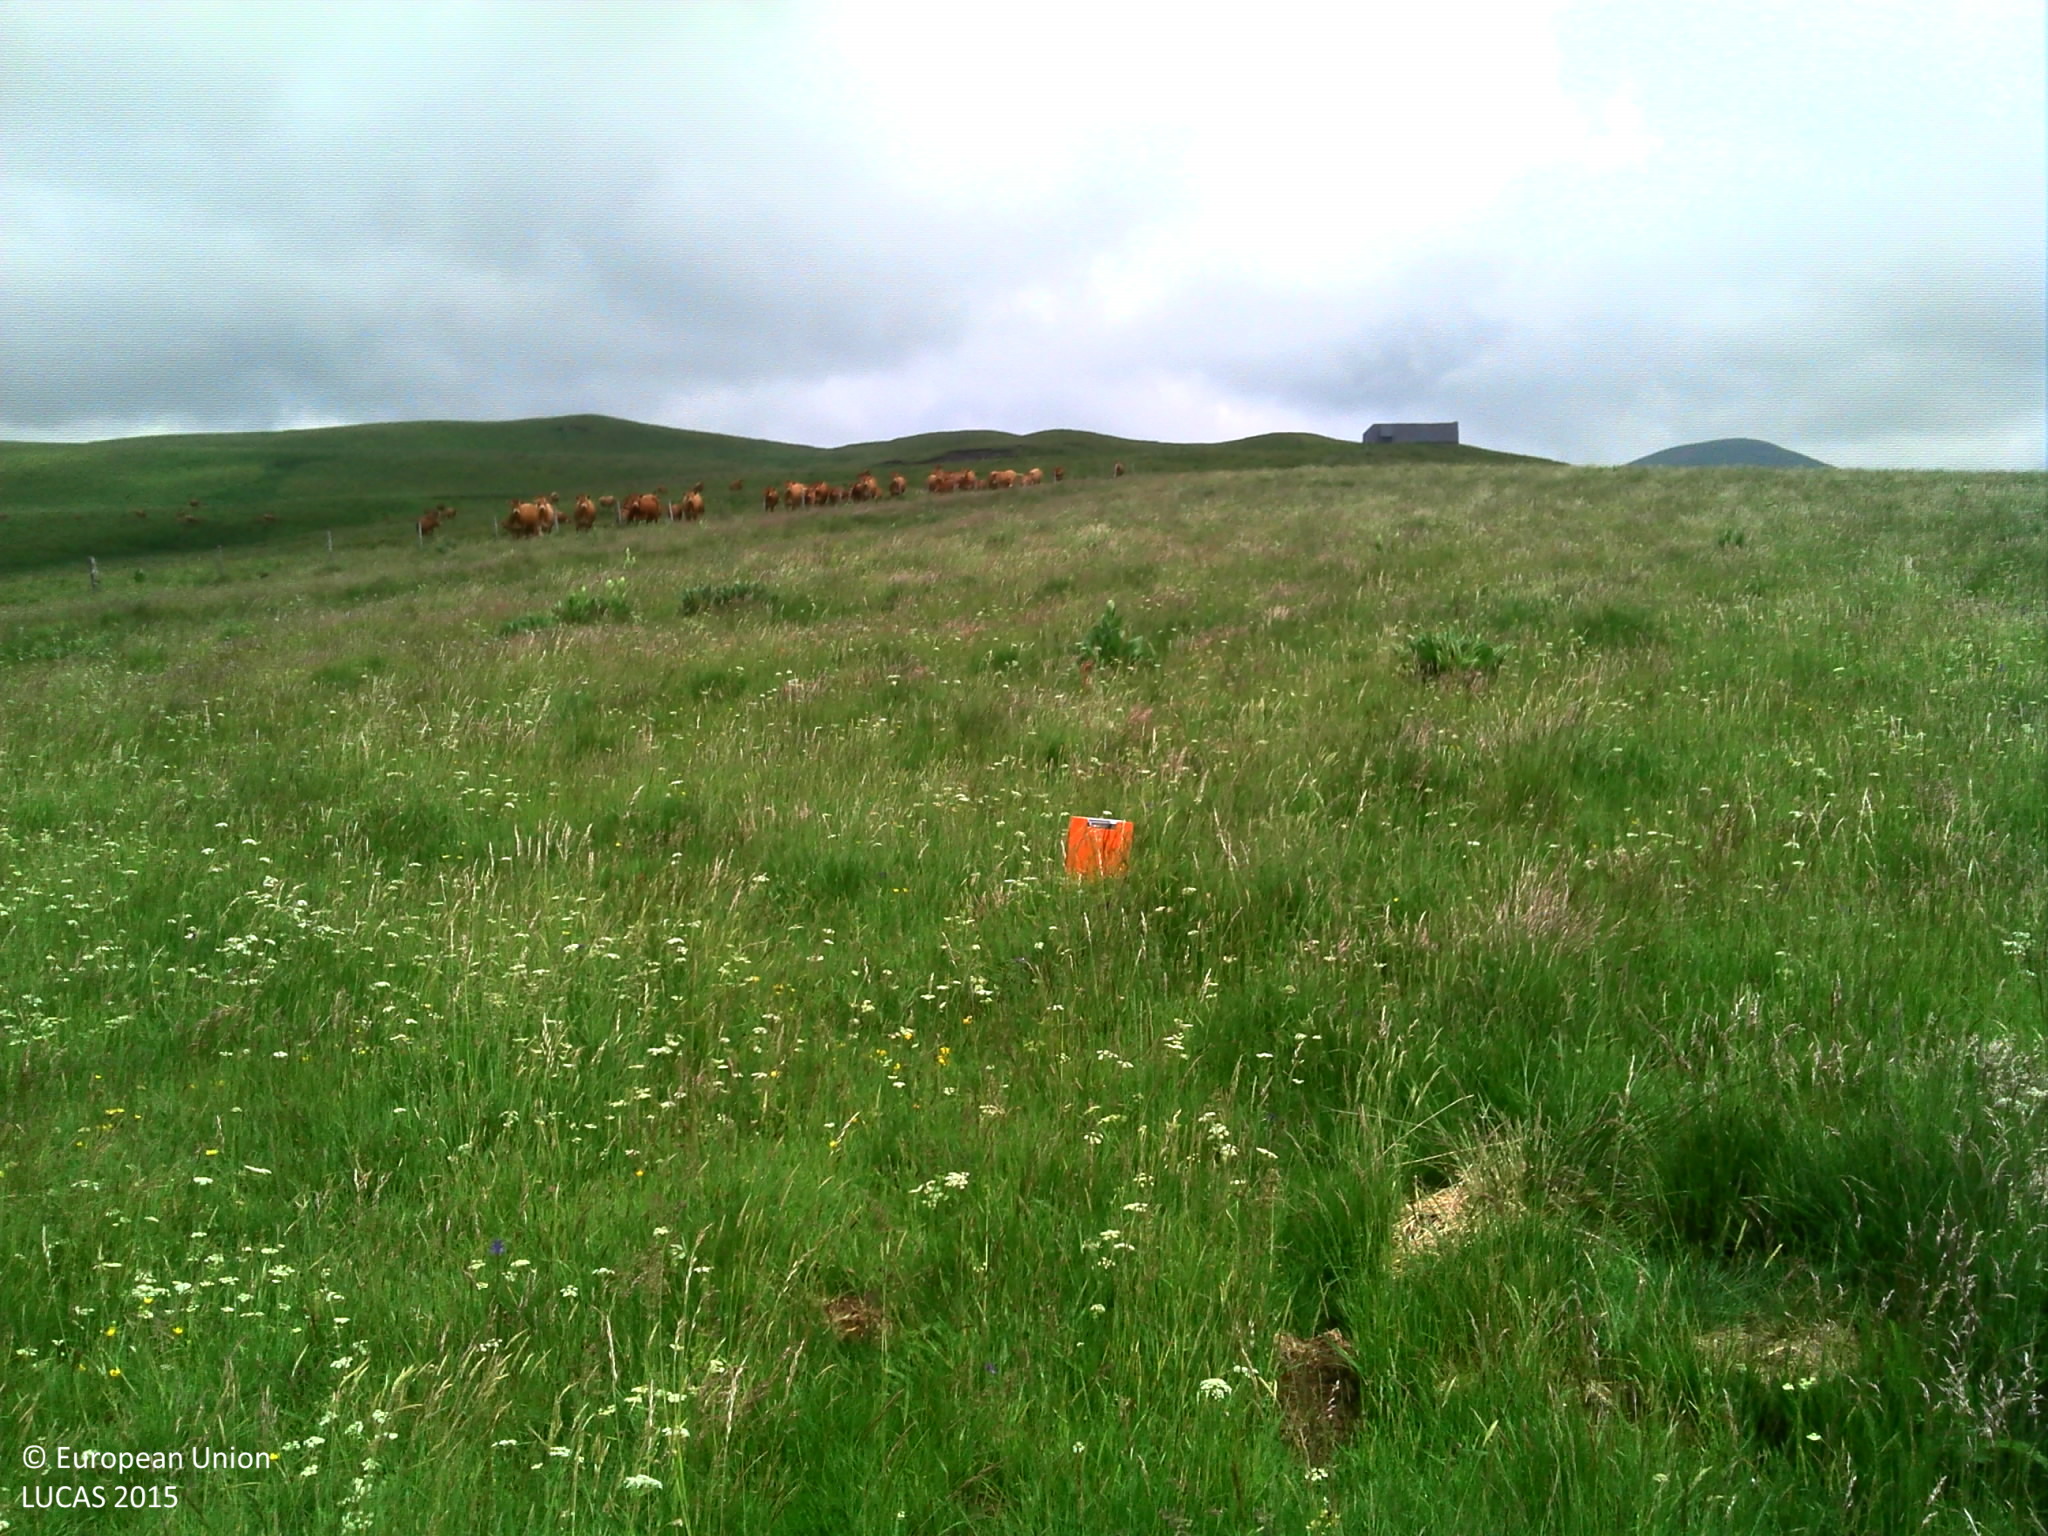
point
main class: Grassland
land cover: Grassland without tree/shrub cover
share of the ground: > 75 %
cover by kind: herbaceous plants 100 %
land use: Agriculture (excluding fallow land and kitchen gardens)
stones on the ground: < 10 %
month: June
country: FR
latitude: 45.3371
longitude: 2.8927
